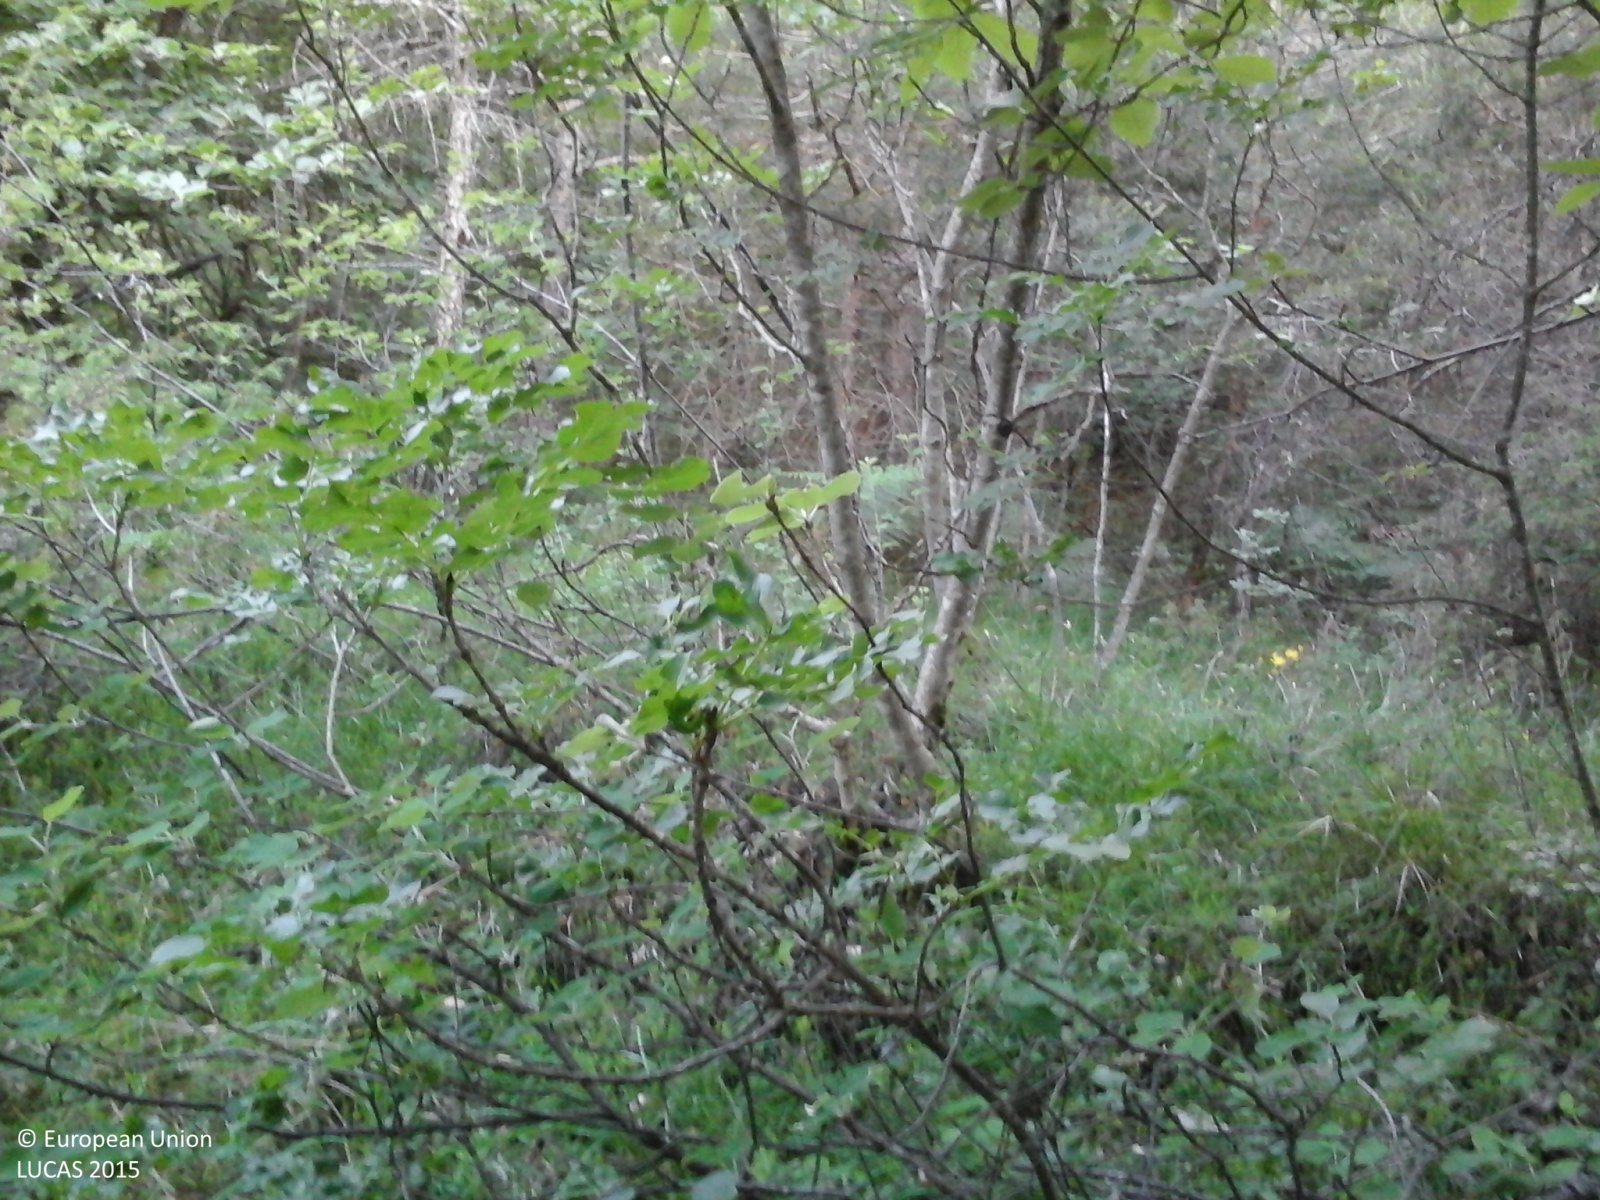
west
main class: Woodland
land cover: Broadleaved woodland
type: mountainous beech forest
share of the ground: > 75 %
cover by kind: broadleaved forest trees 100 %
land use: Forestry
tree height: > 5 m
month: June
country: IT
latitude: 45.9865
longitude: 10.9668
